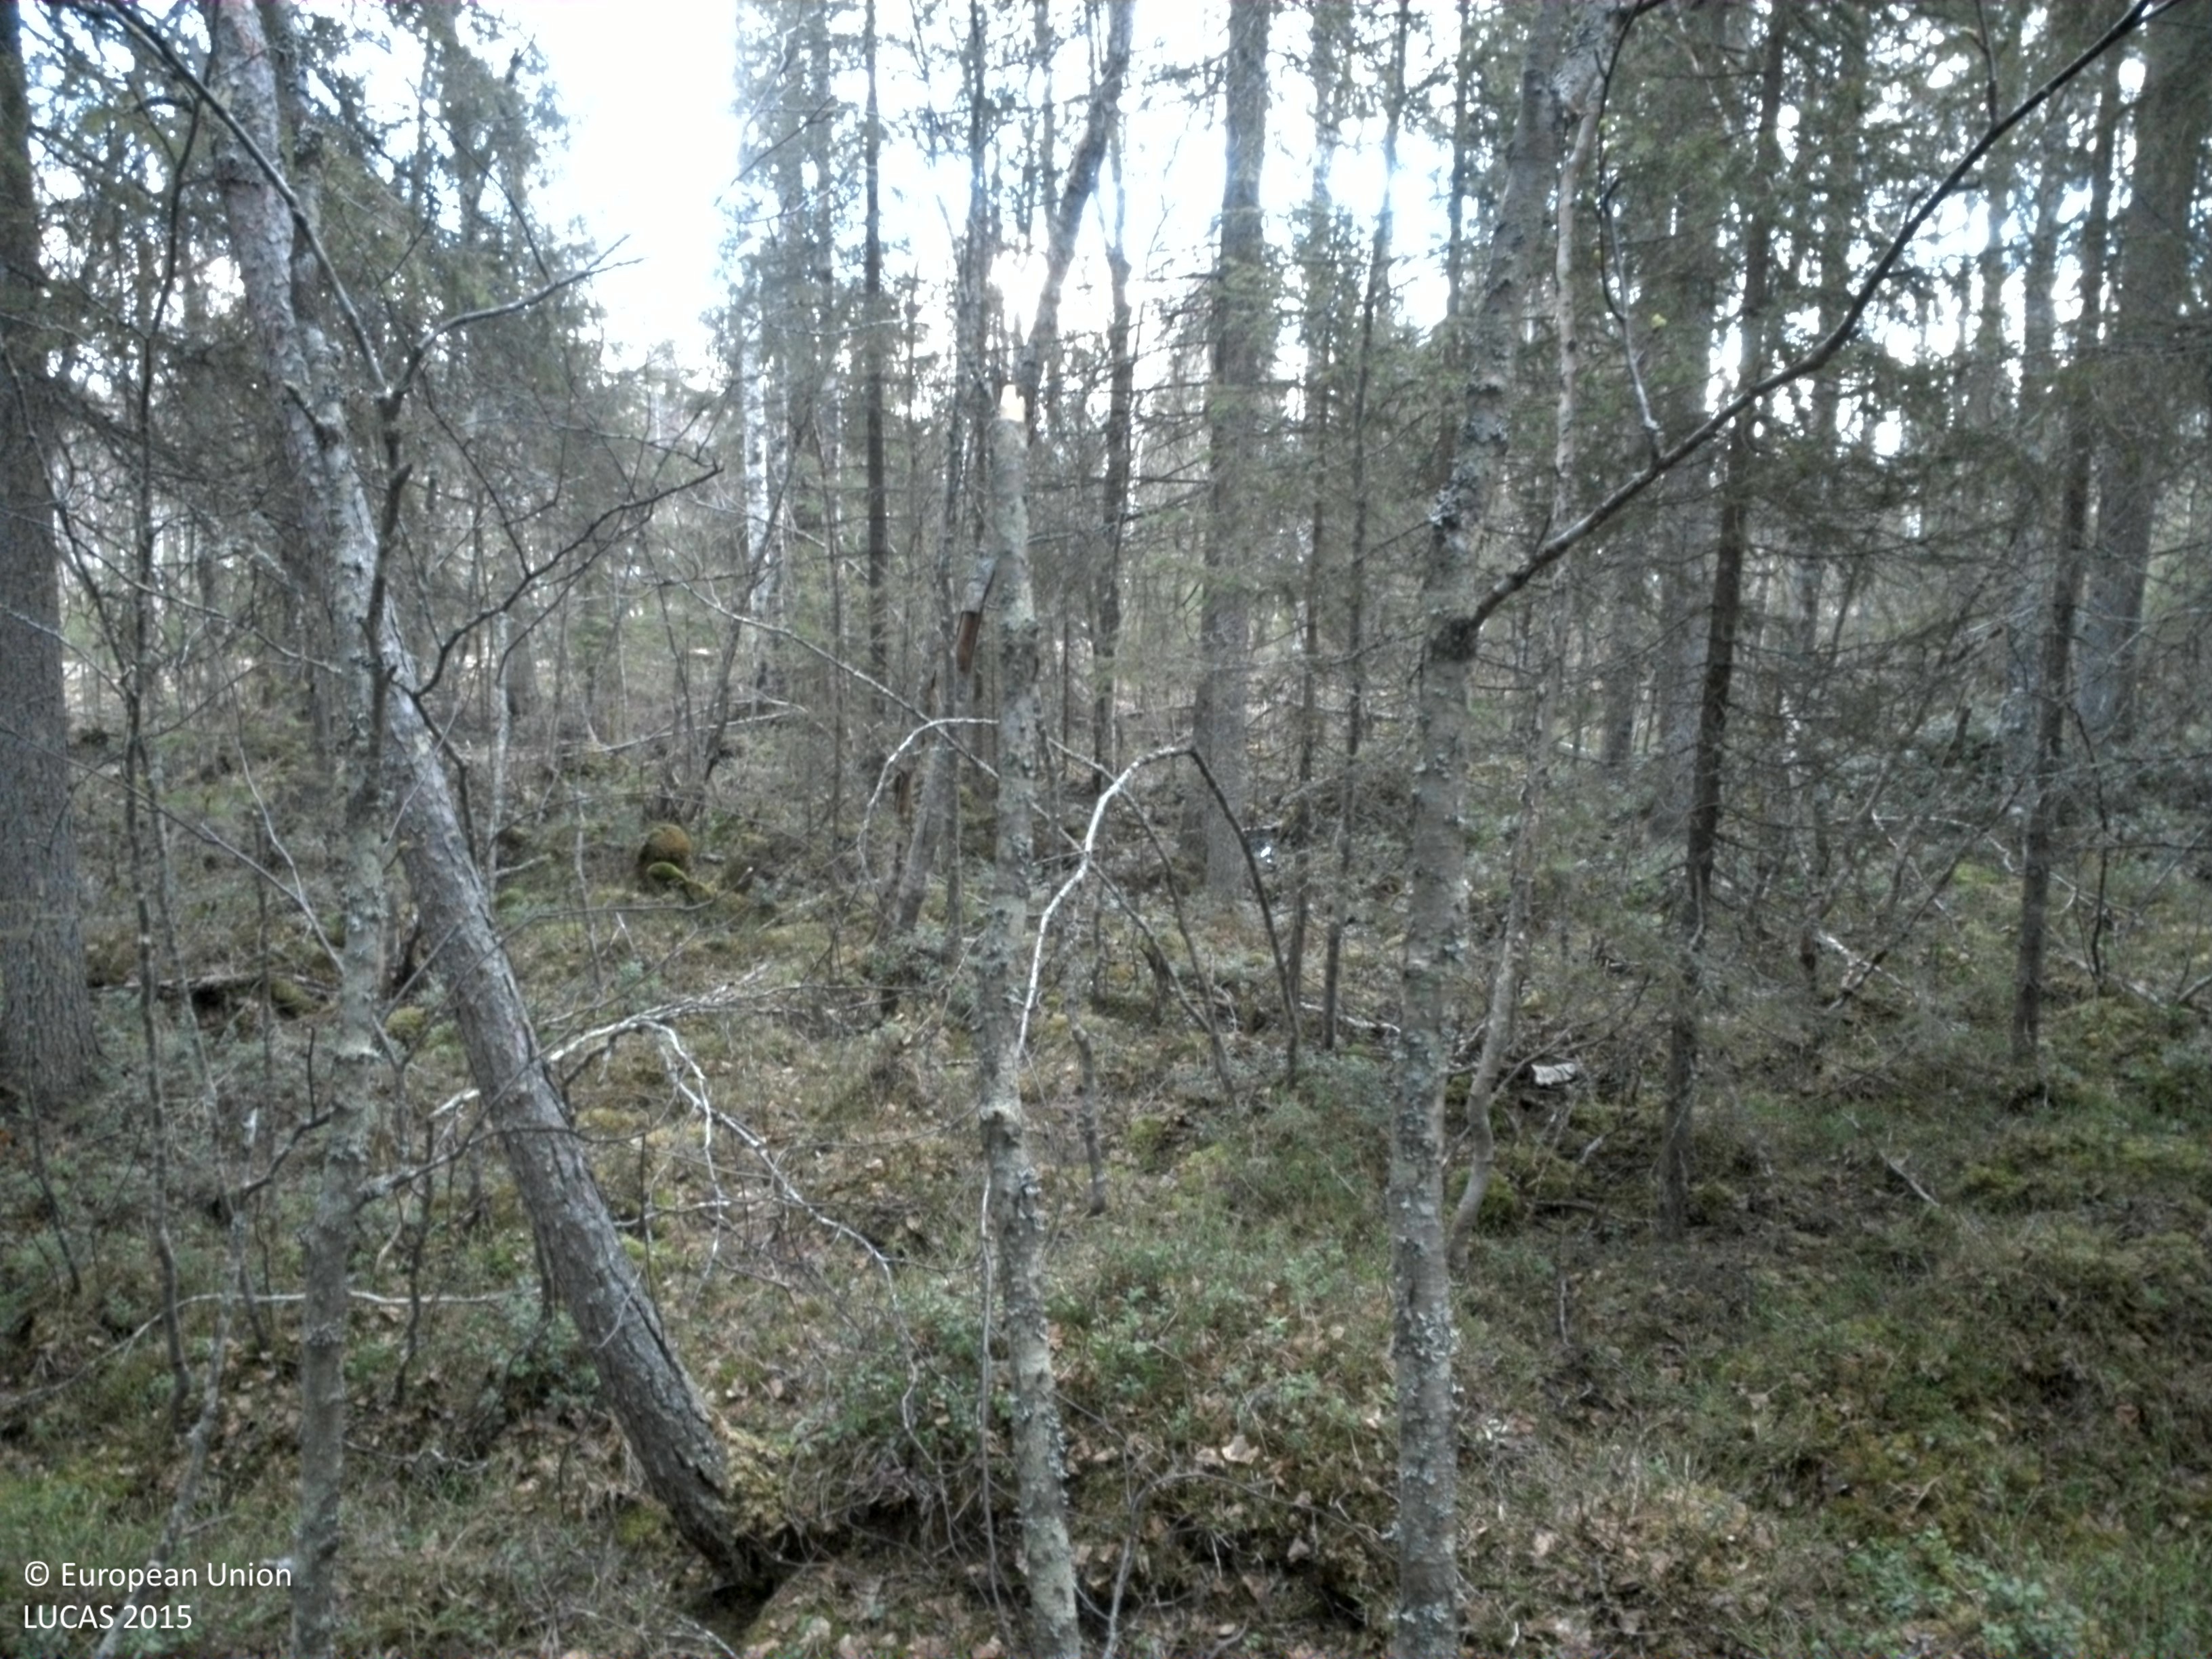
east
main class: Woodland
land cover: Spruce dominated mixed woodland
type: boreal forest
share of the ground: > 75 %
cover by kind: coniferous forest trees 60 %, broadleaved forest trees 25 %, shrubs 15 %
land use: Forestry
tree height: > 5 m
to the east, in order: Spruce dominated mixed woodland; Ditches and canals; Grass margins; Paved roads, cycling and walking lanes; Shruby margins; Spruce dominated coniferous woodland; Spruce dominated mixed woodland; Shruby margins; Paved roads, cycling and walking lanes; Shrubland without tree cover; Spruce dominated mixed woodland; Rivers and streams; Broadleaved woodland
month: May
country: SE
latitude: 66.3217
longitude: 23.4867
